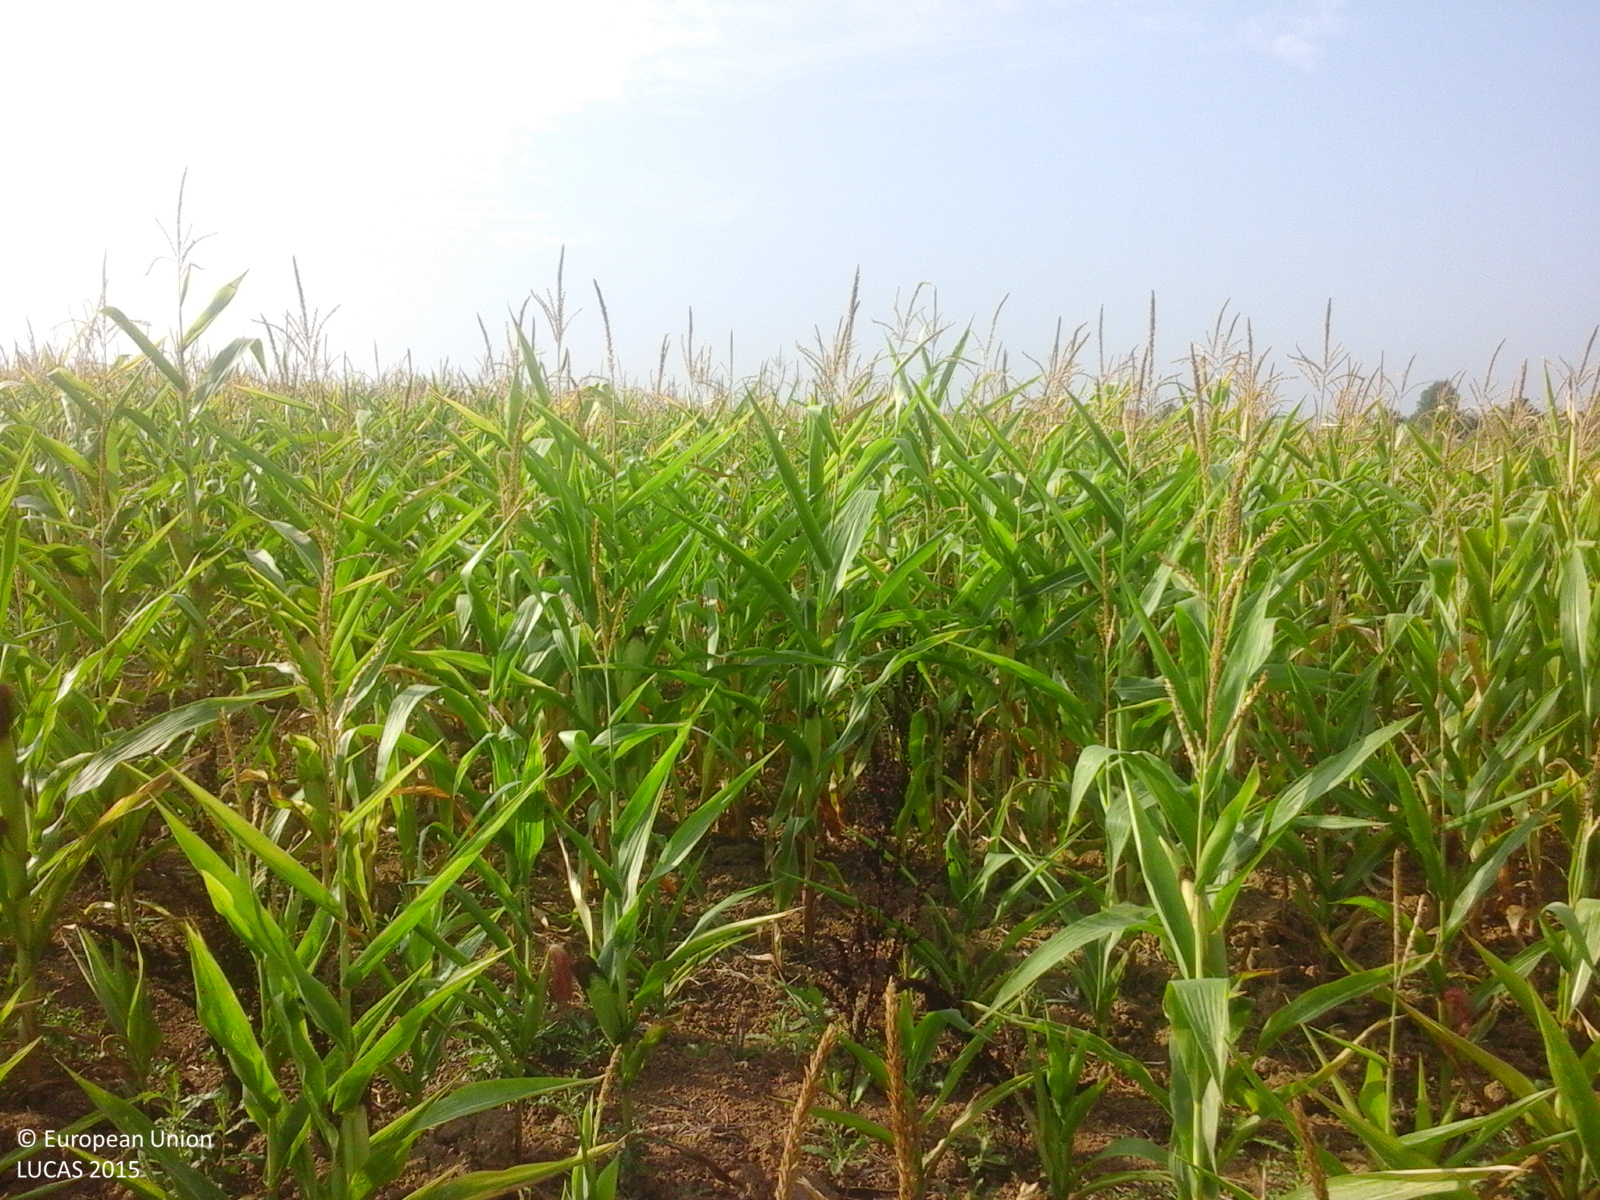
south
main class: Cropland
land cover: Maize
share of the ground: > 75 %
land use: Agriculture (excluding fallow land and kitchen gardens)
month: August
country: RO
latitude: 46.4248
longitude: 21.9495
